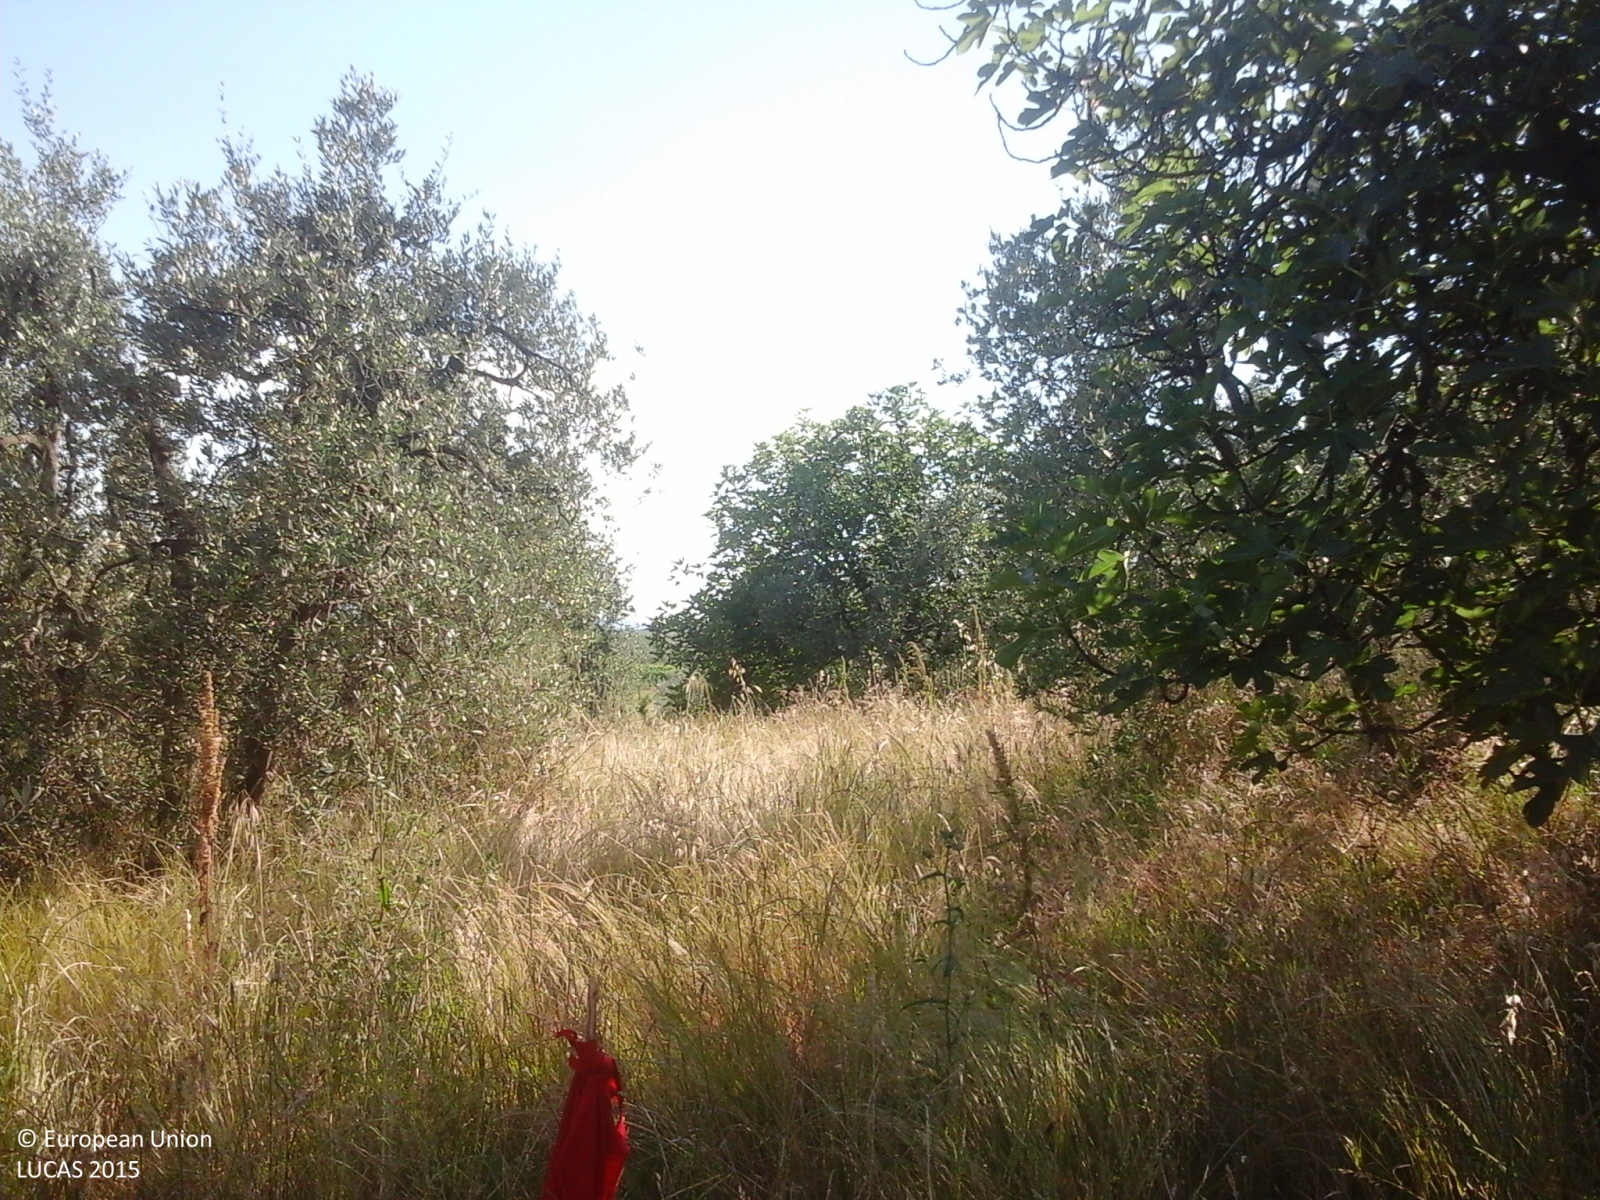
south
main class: Cropland
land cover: Olive groves
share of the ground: 50 - 75 %
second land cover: Grassland without tree/shrub cover
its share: > 75 %
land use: Agriculture (excluding fallow land and kitchen gardens)
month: June
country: IT
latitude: 43.7508
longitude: 10.9537
